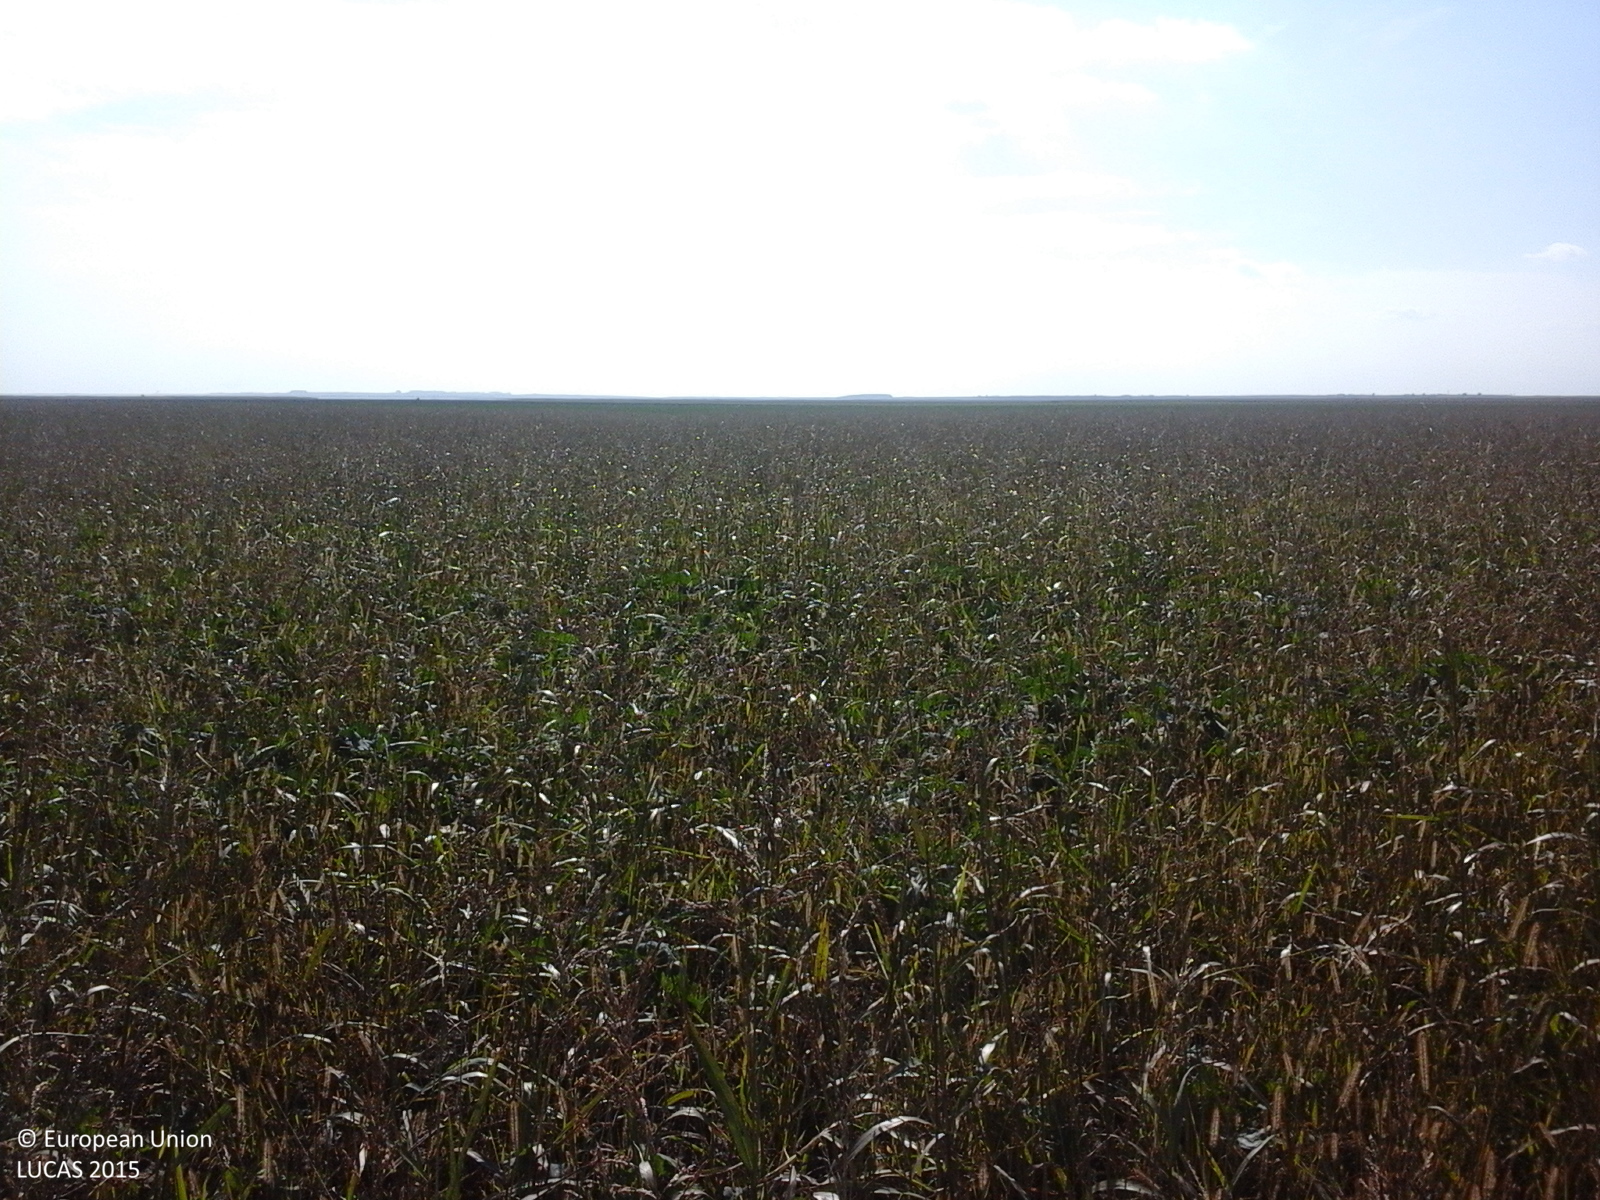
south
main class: Grassland
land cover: Spontaneously vegetated surfaces
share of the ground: > 75 %
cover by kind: herbaceous plants 100 %
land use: Fallow land
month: October
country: RO
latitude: 45.4494
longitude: 27.3723
